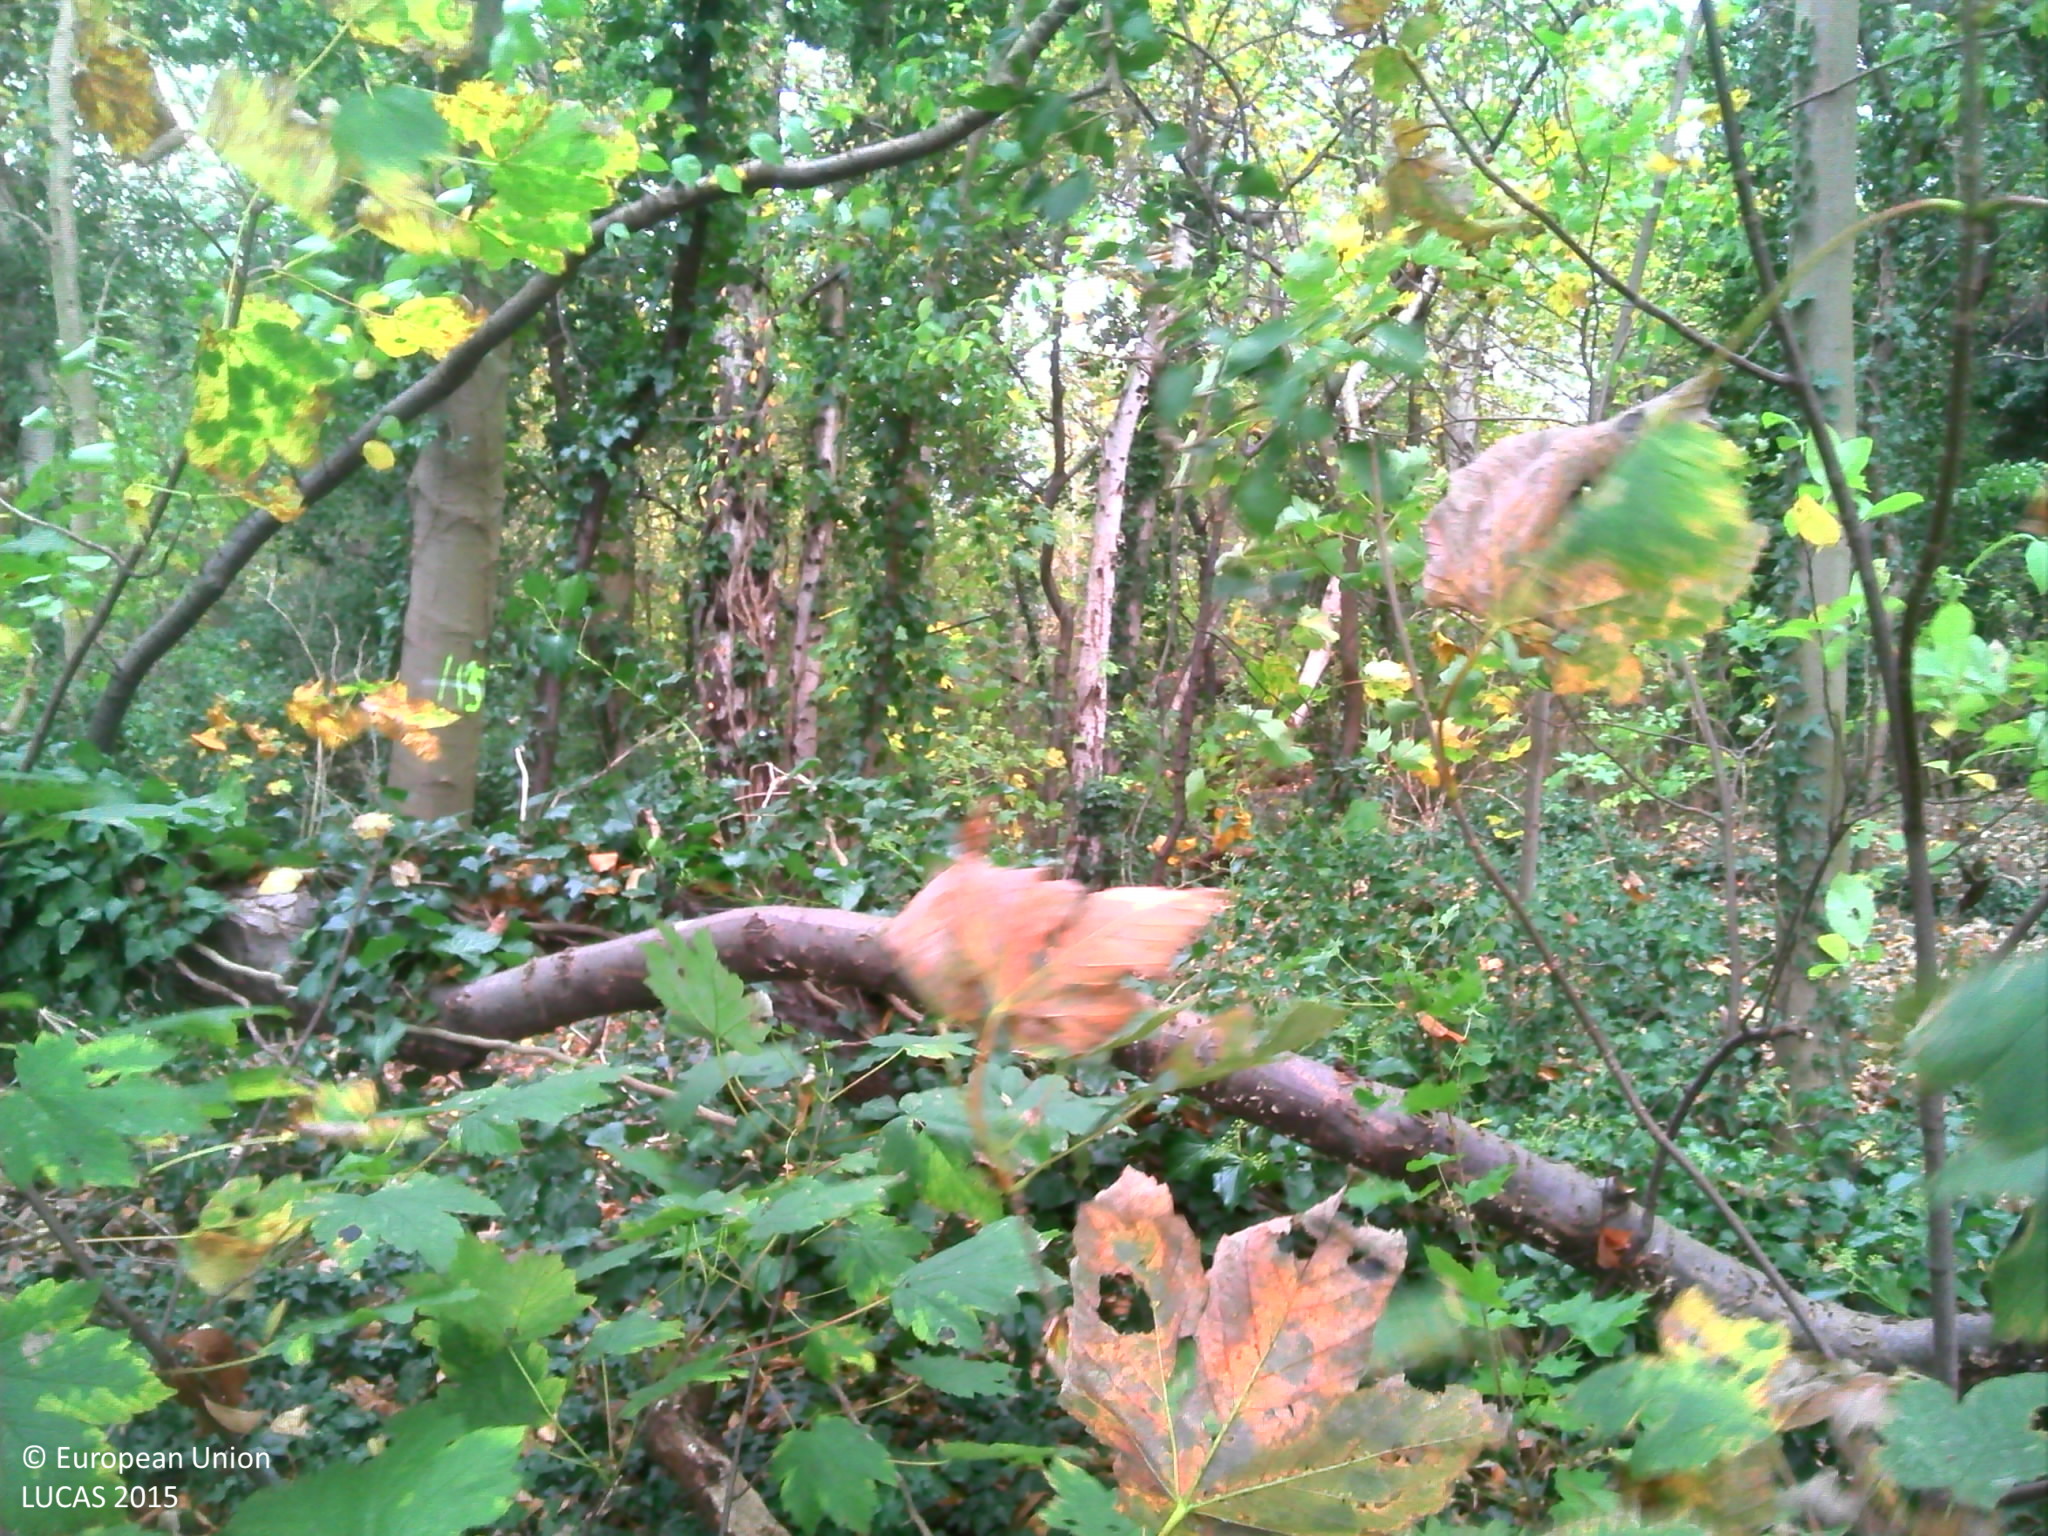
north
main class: Woodland
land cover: Broadleaved woodland
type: mesophytic deciduous forest
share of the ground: > 75 %
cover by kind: broadleaved forest trees 95 %, herbaceous plants 5 %
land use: Forestry
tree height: > 5 m
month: November
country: BE
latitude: 51.0071
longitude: 4.5088
